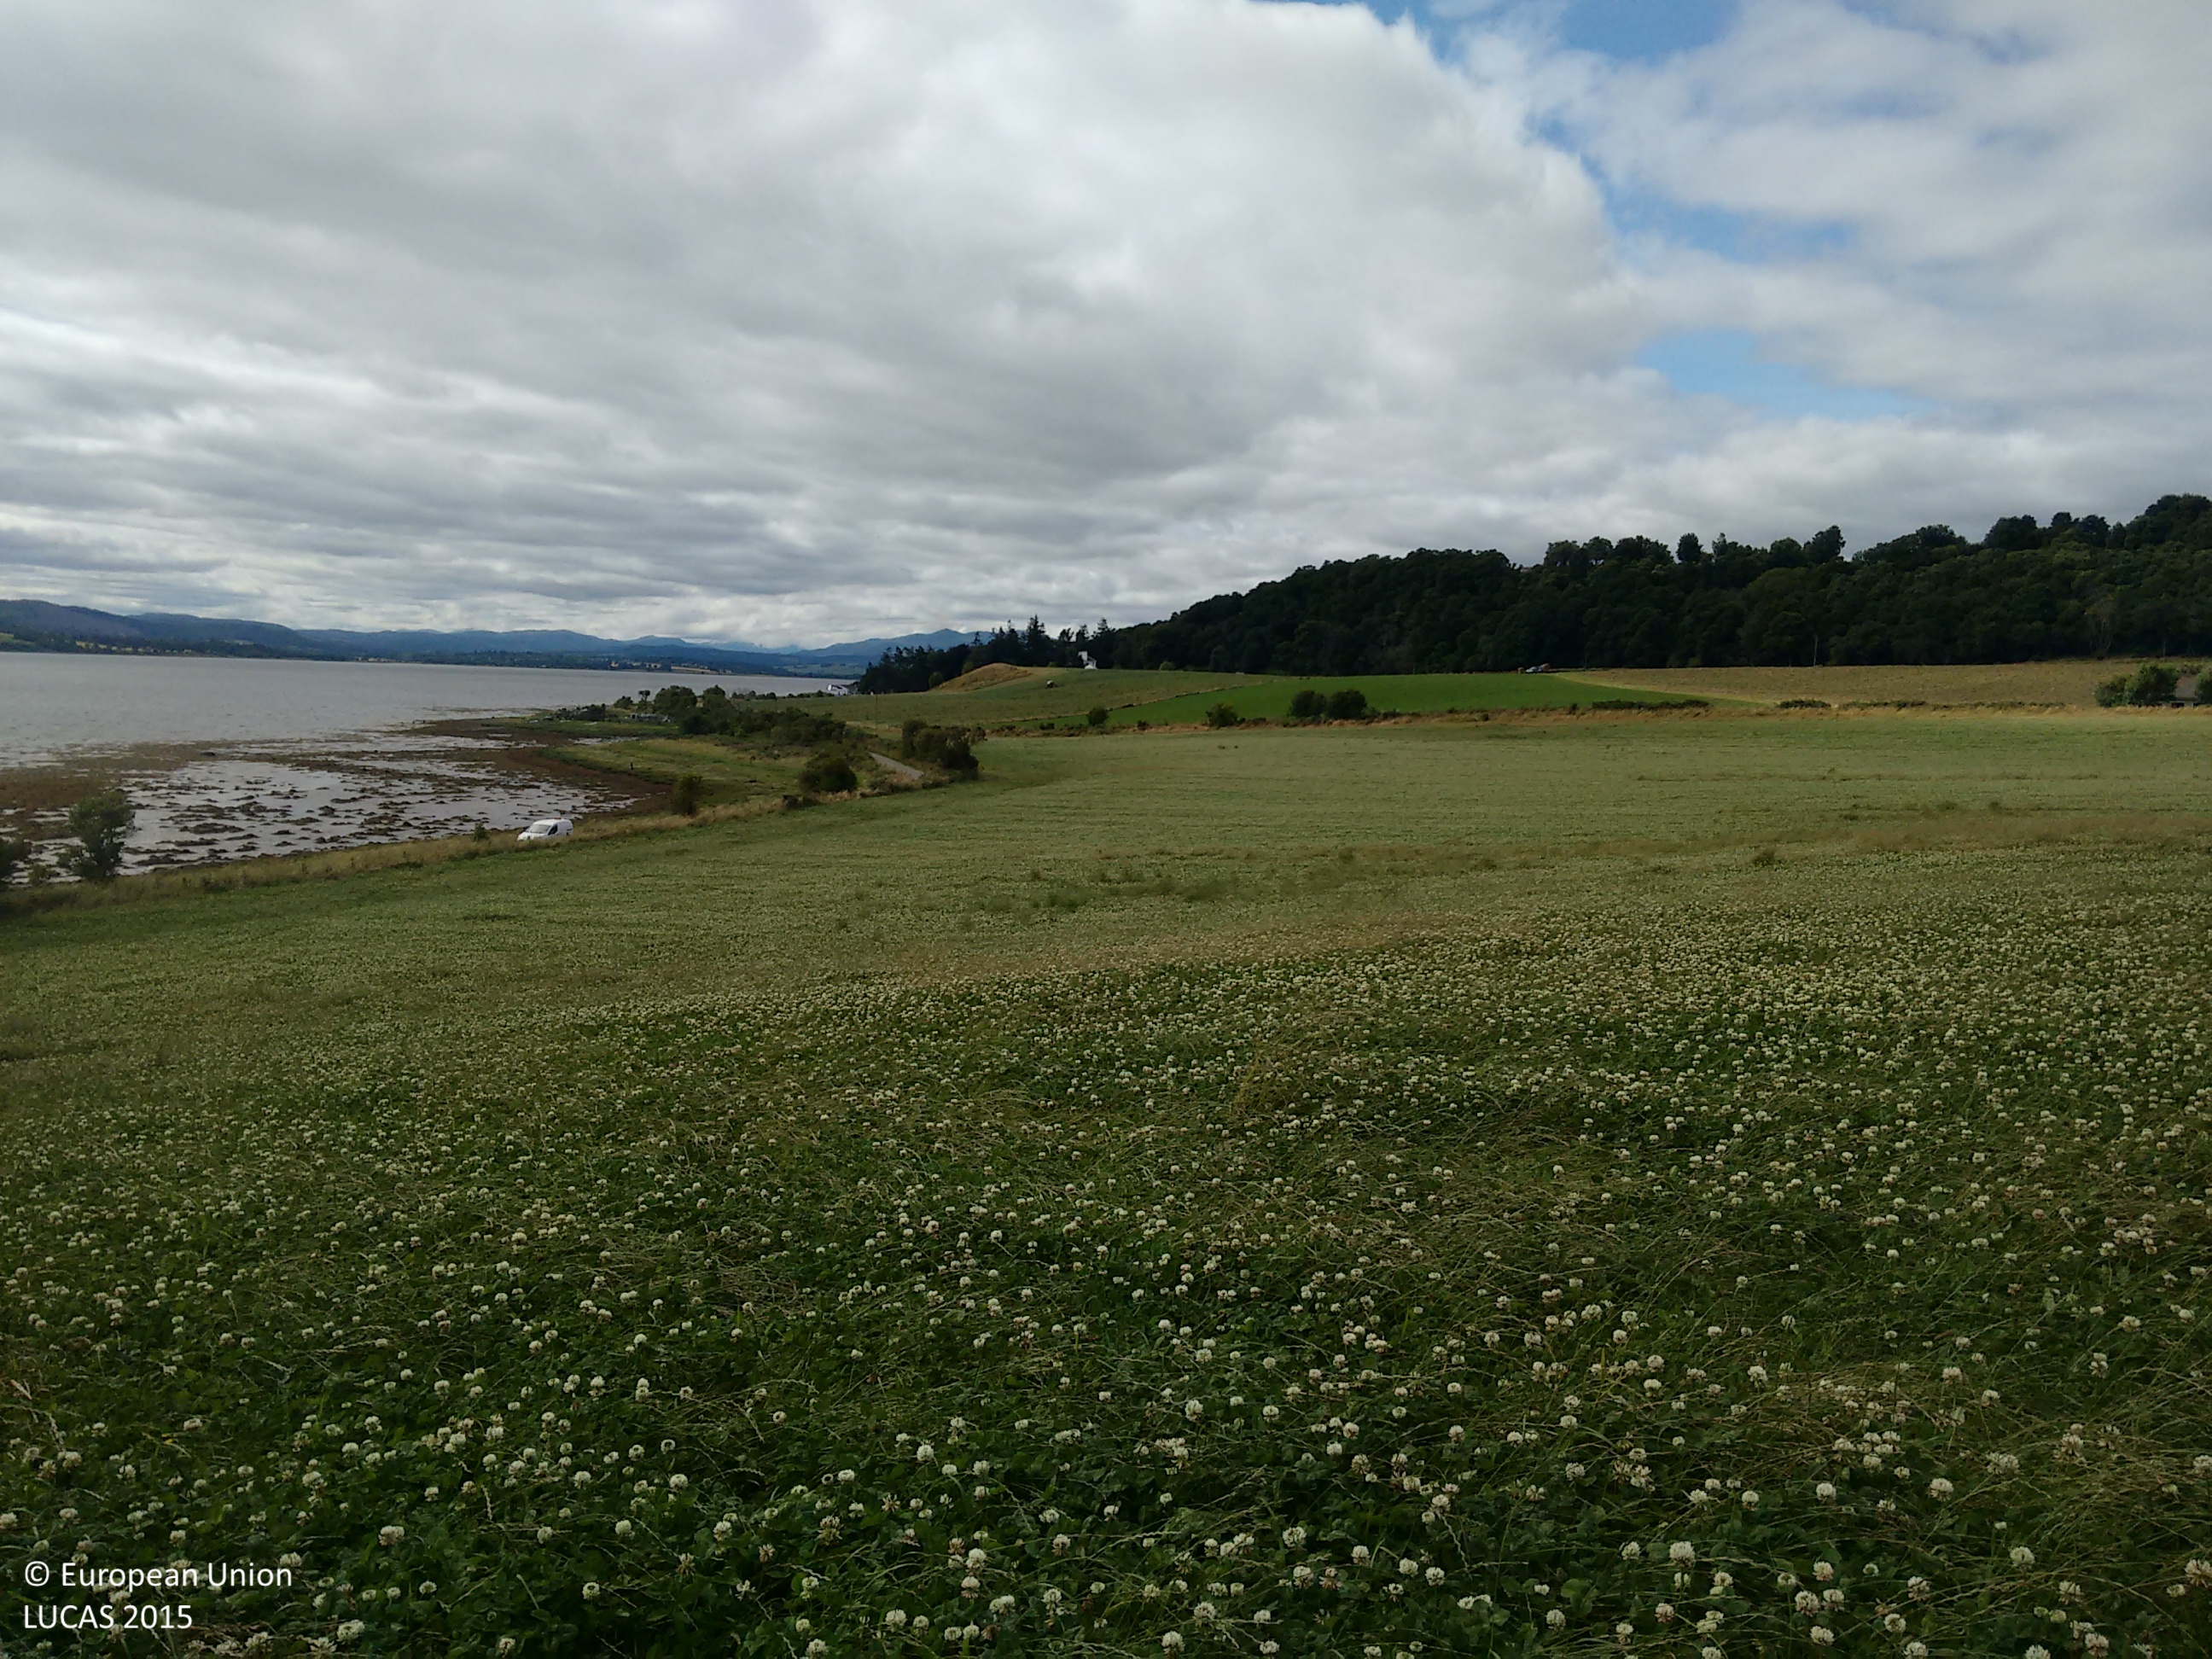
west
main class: Cropland
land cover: Clovers
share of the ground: > 75 %
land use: Agriculture (excluding fallow land and kitchen gardens)
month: August
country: GB
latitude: 57.5053
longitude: -4.2892
